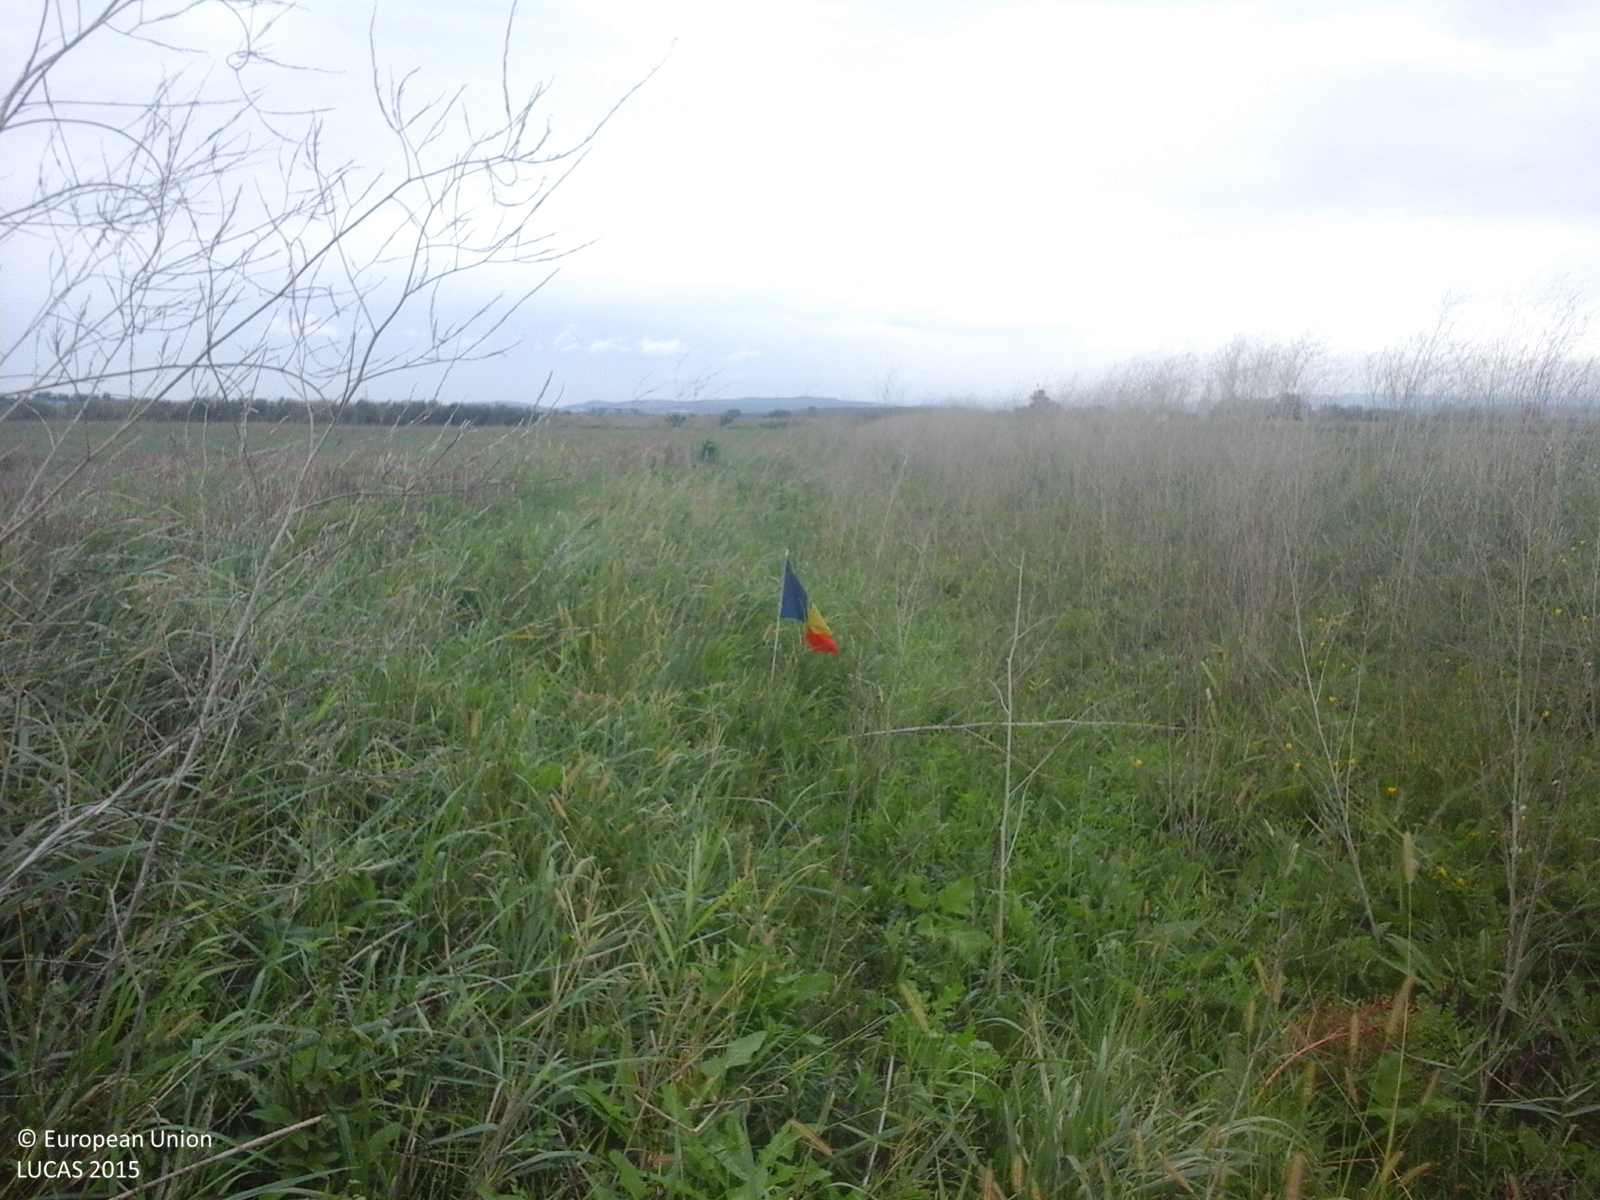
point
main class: Grassland
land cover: Spontaneously vegetated surfaces
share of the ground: > 75 %
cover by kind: herbaceous plants 100 %
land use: Fallow land
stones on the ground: < 10 %
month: September
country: RO
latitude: 45.8815
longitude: 23.0049
